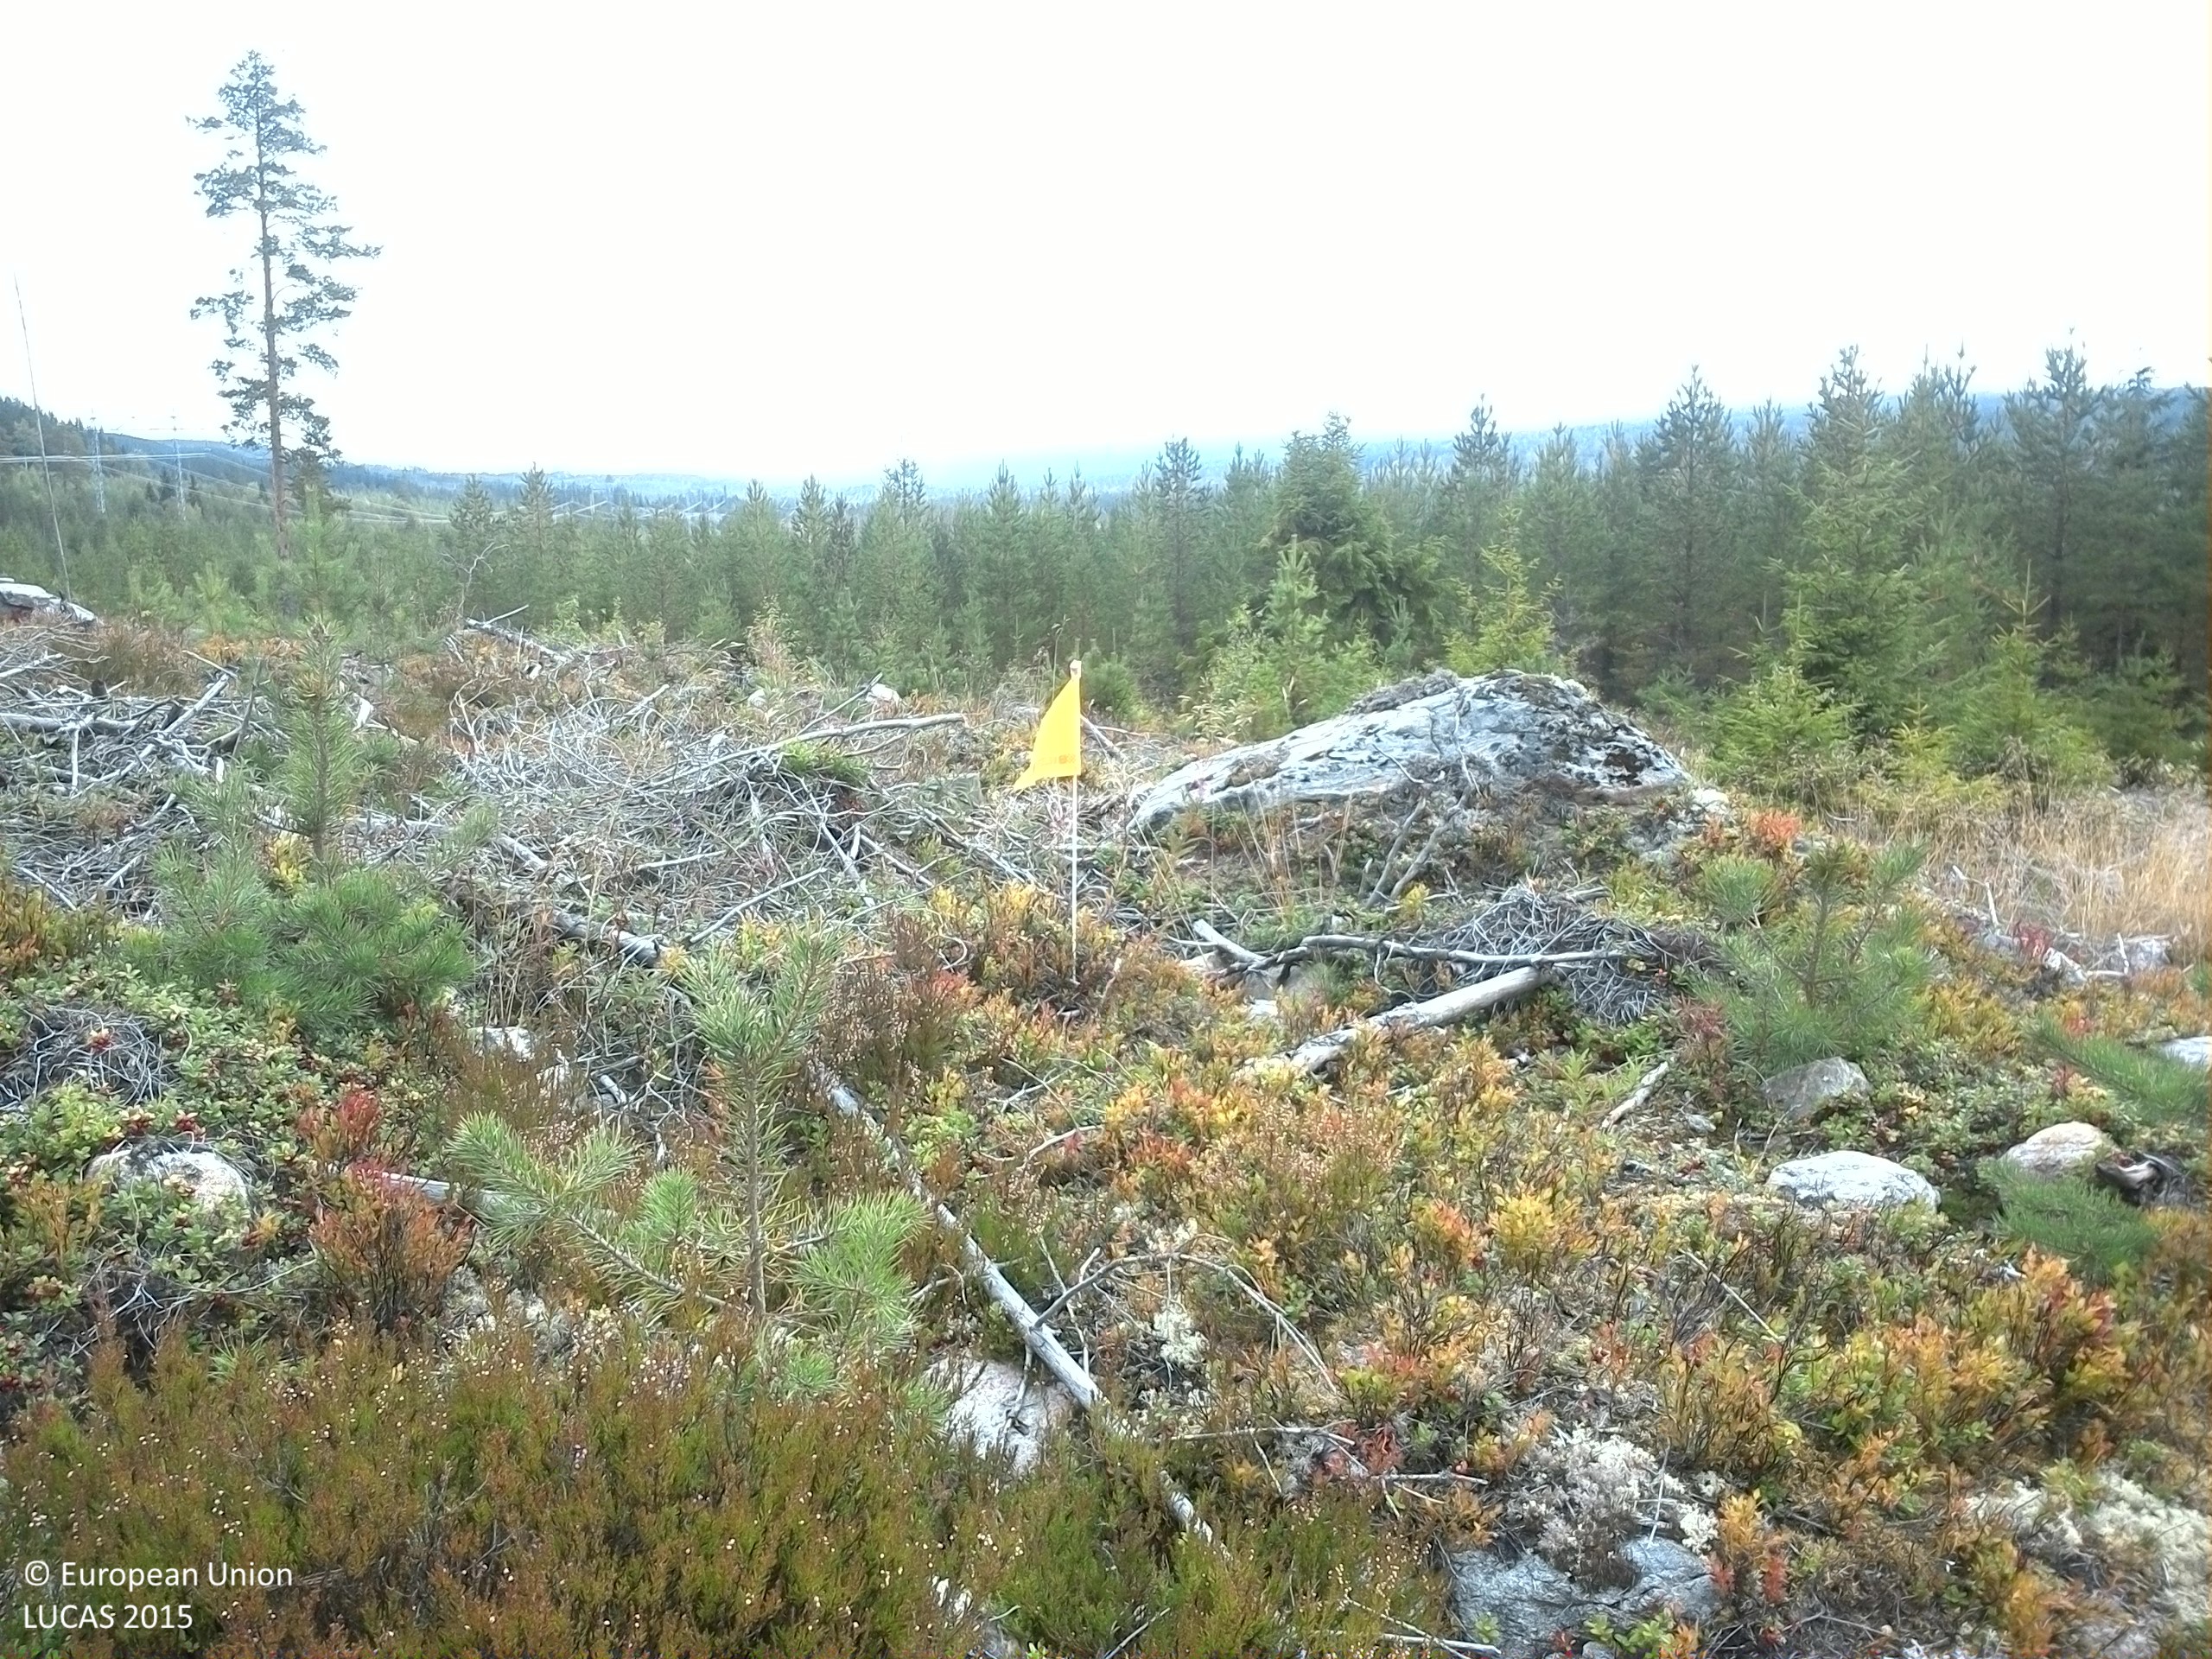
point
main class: Shrubland
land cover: Shrubland with sparse tree cover
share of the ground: > 75 %
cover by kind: shrubs 60 %, consolidated bare surface 20 %, lichens and mosses 15 %, coniferous forest trees 5 %
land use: Forestry
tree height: < 5 m
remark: Clear cut
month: September
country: SE
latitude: 61.6675
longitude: 15.3665
